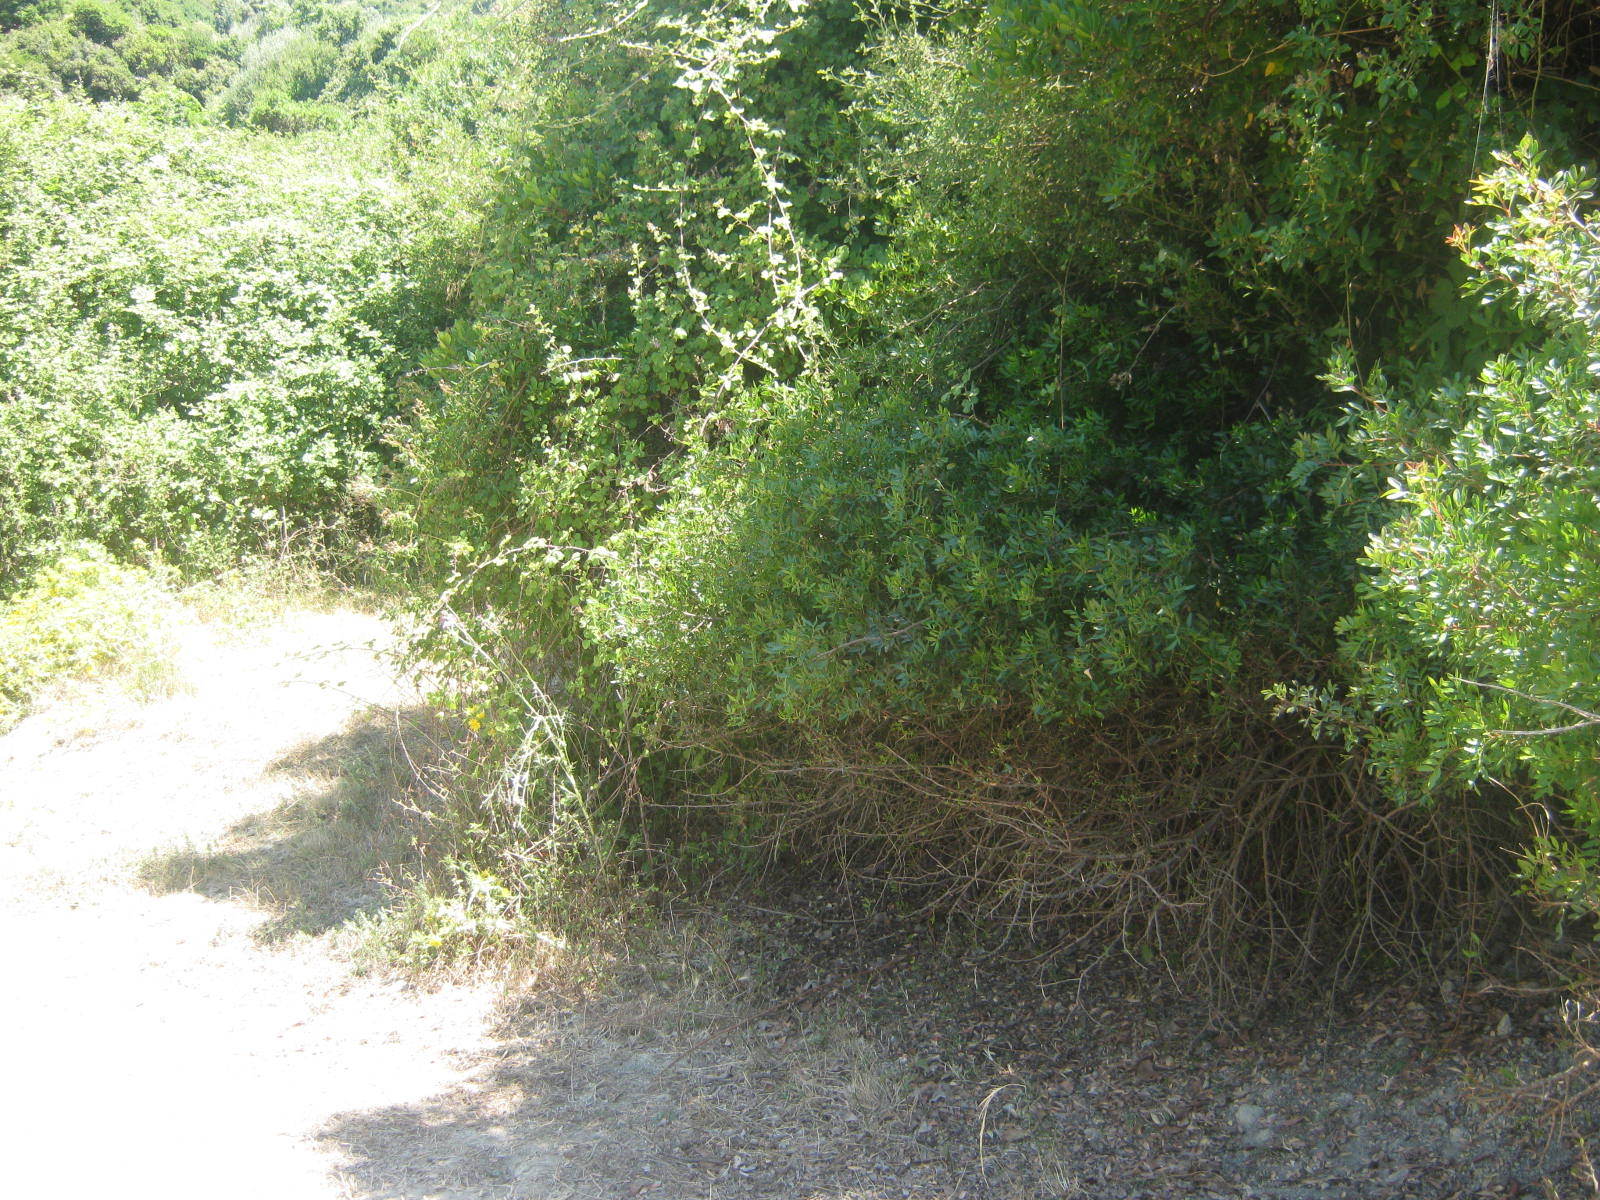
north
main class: Grassland
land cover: Grassland with sparse tree/shrub cover
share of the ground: > 75 %
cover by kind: herbaceous plants 75 %, shrubs 10 %, unconsolidated bare surface 10 %, broadleaved forest trees 5 %
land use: Fallow land
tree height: < 5 m
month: June
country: GR
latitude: 38.8289
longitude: 20.8086
